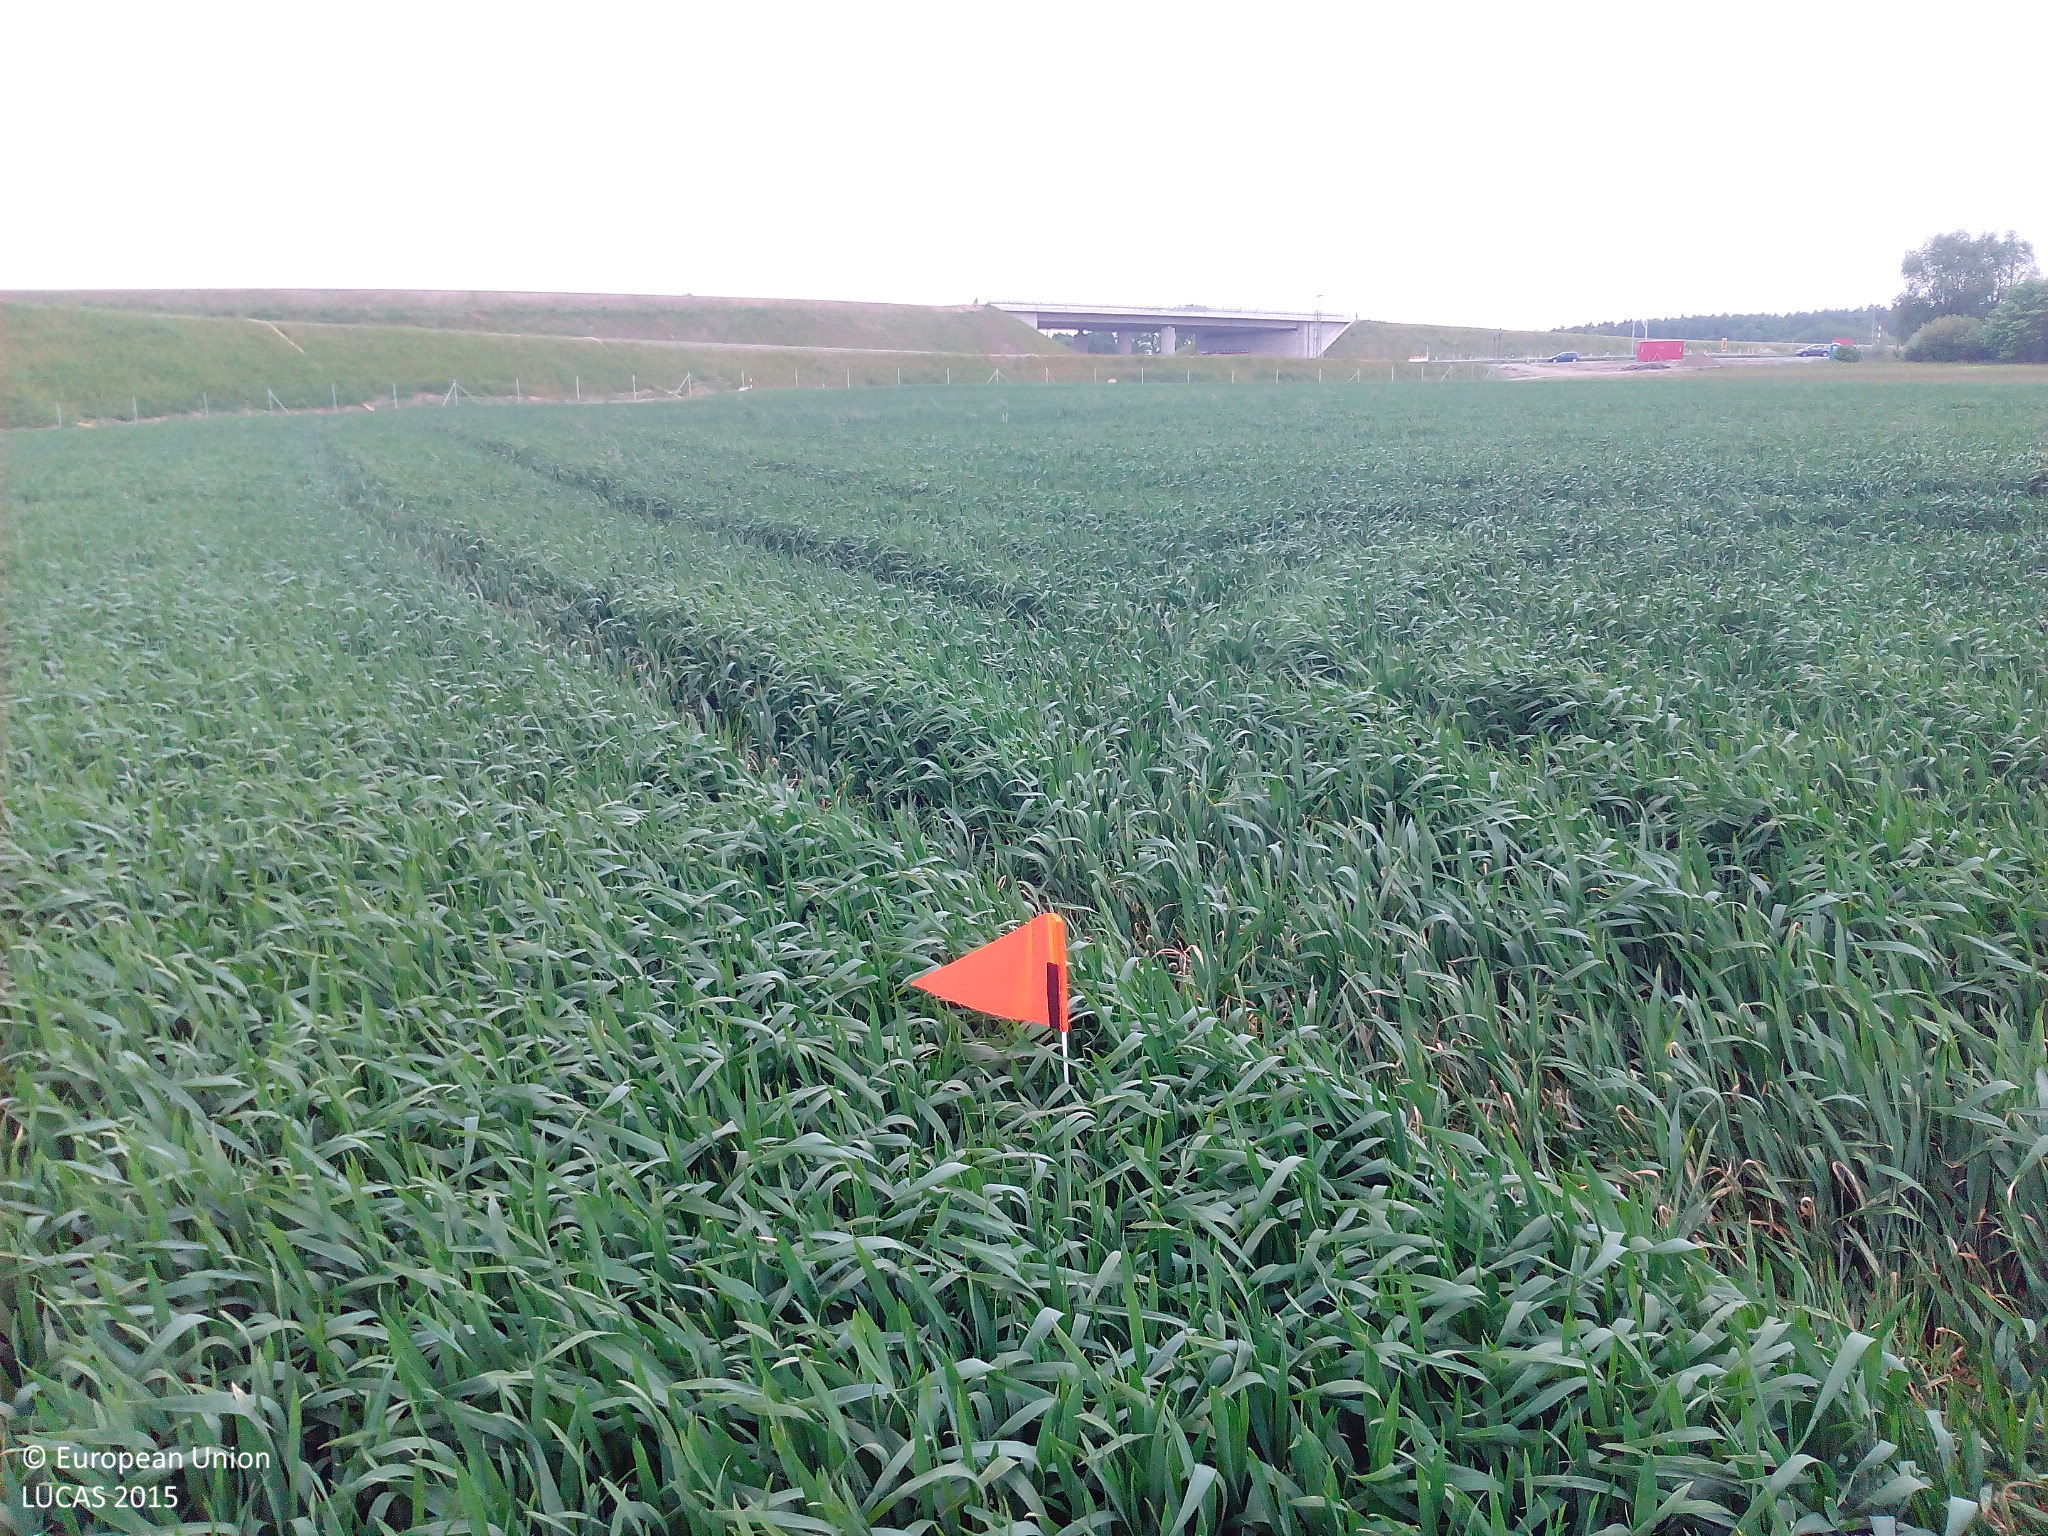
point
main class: Cropland
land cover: Common wheat
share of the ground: > 75 %
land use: Agriculture (excluding fallow land and kitchen gardens)
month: June
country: DE
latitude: 54.3642
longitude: 13.3081
